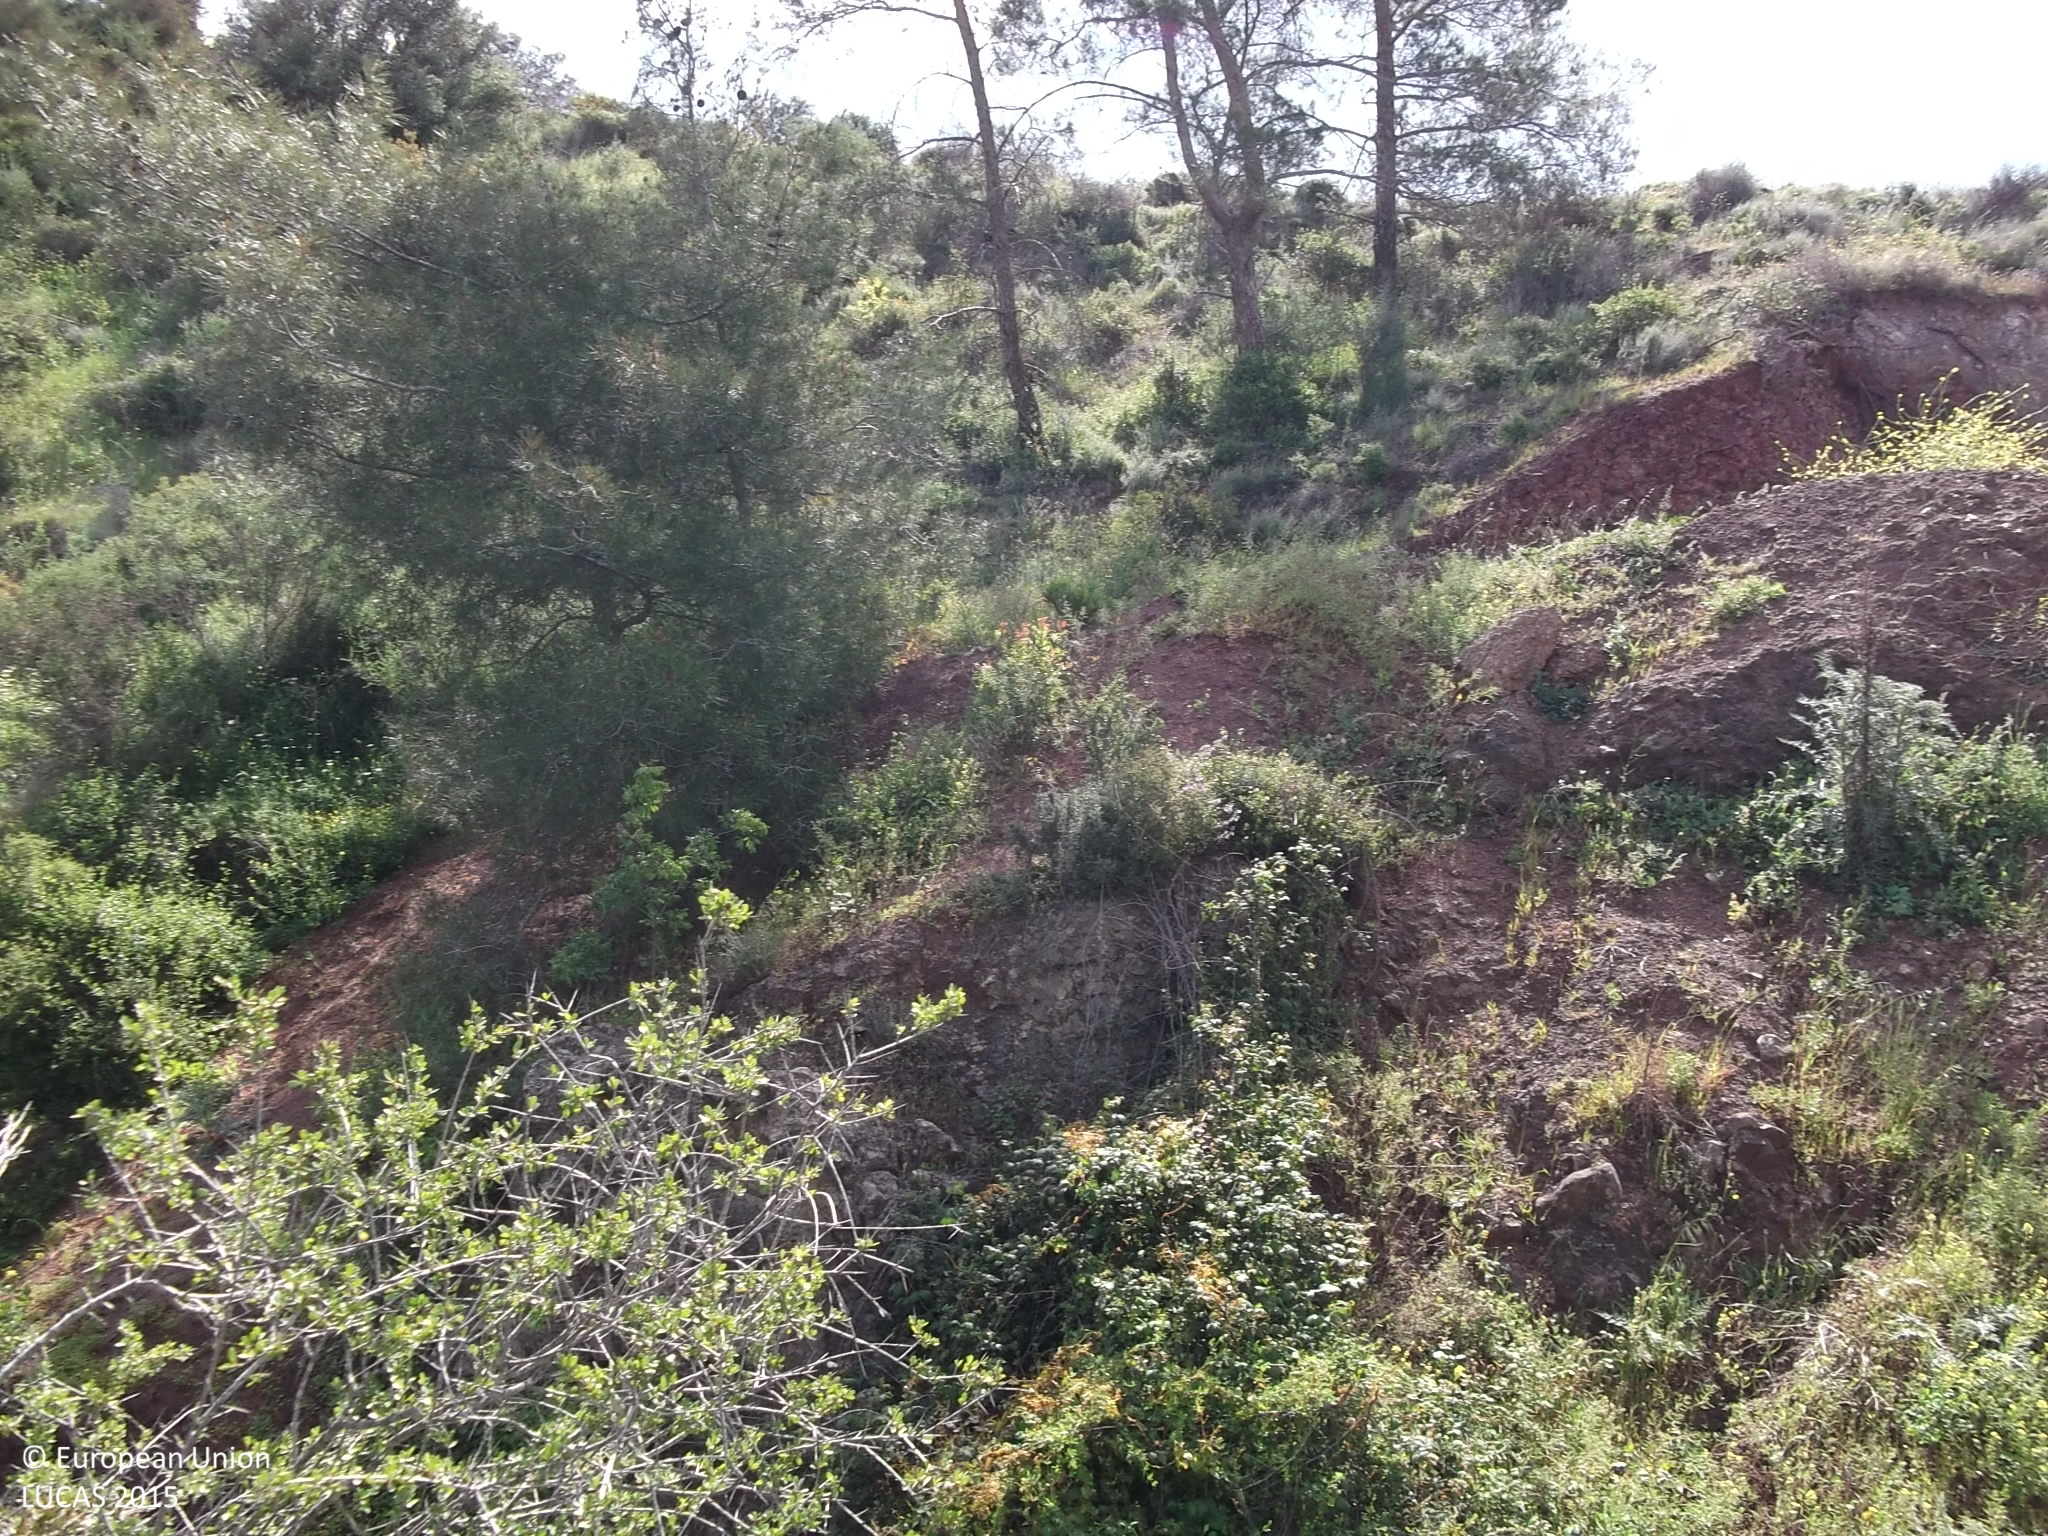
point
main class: Shrubland
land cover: Shrubland with sparse tree cover
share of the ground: 50 - 75 %
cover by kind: shrubs 50 %, herbaceous plants 25 %, consolidated bare surface 10 %, unconsolidated bare surface 10 %, coniferous forest trees 5 %
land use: Semi-natural and natural areas not in use
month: April
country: CY
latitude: 34.8525
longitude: 33.4274
